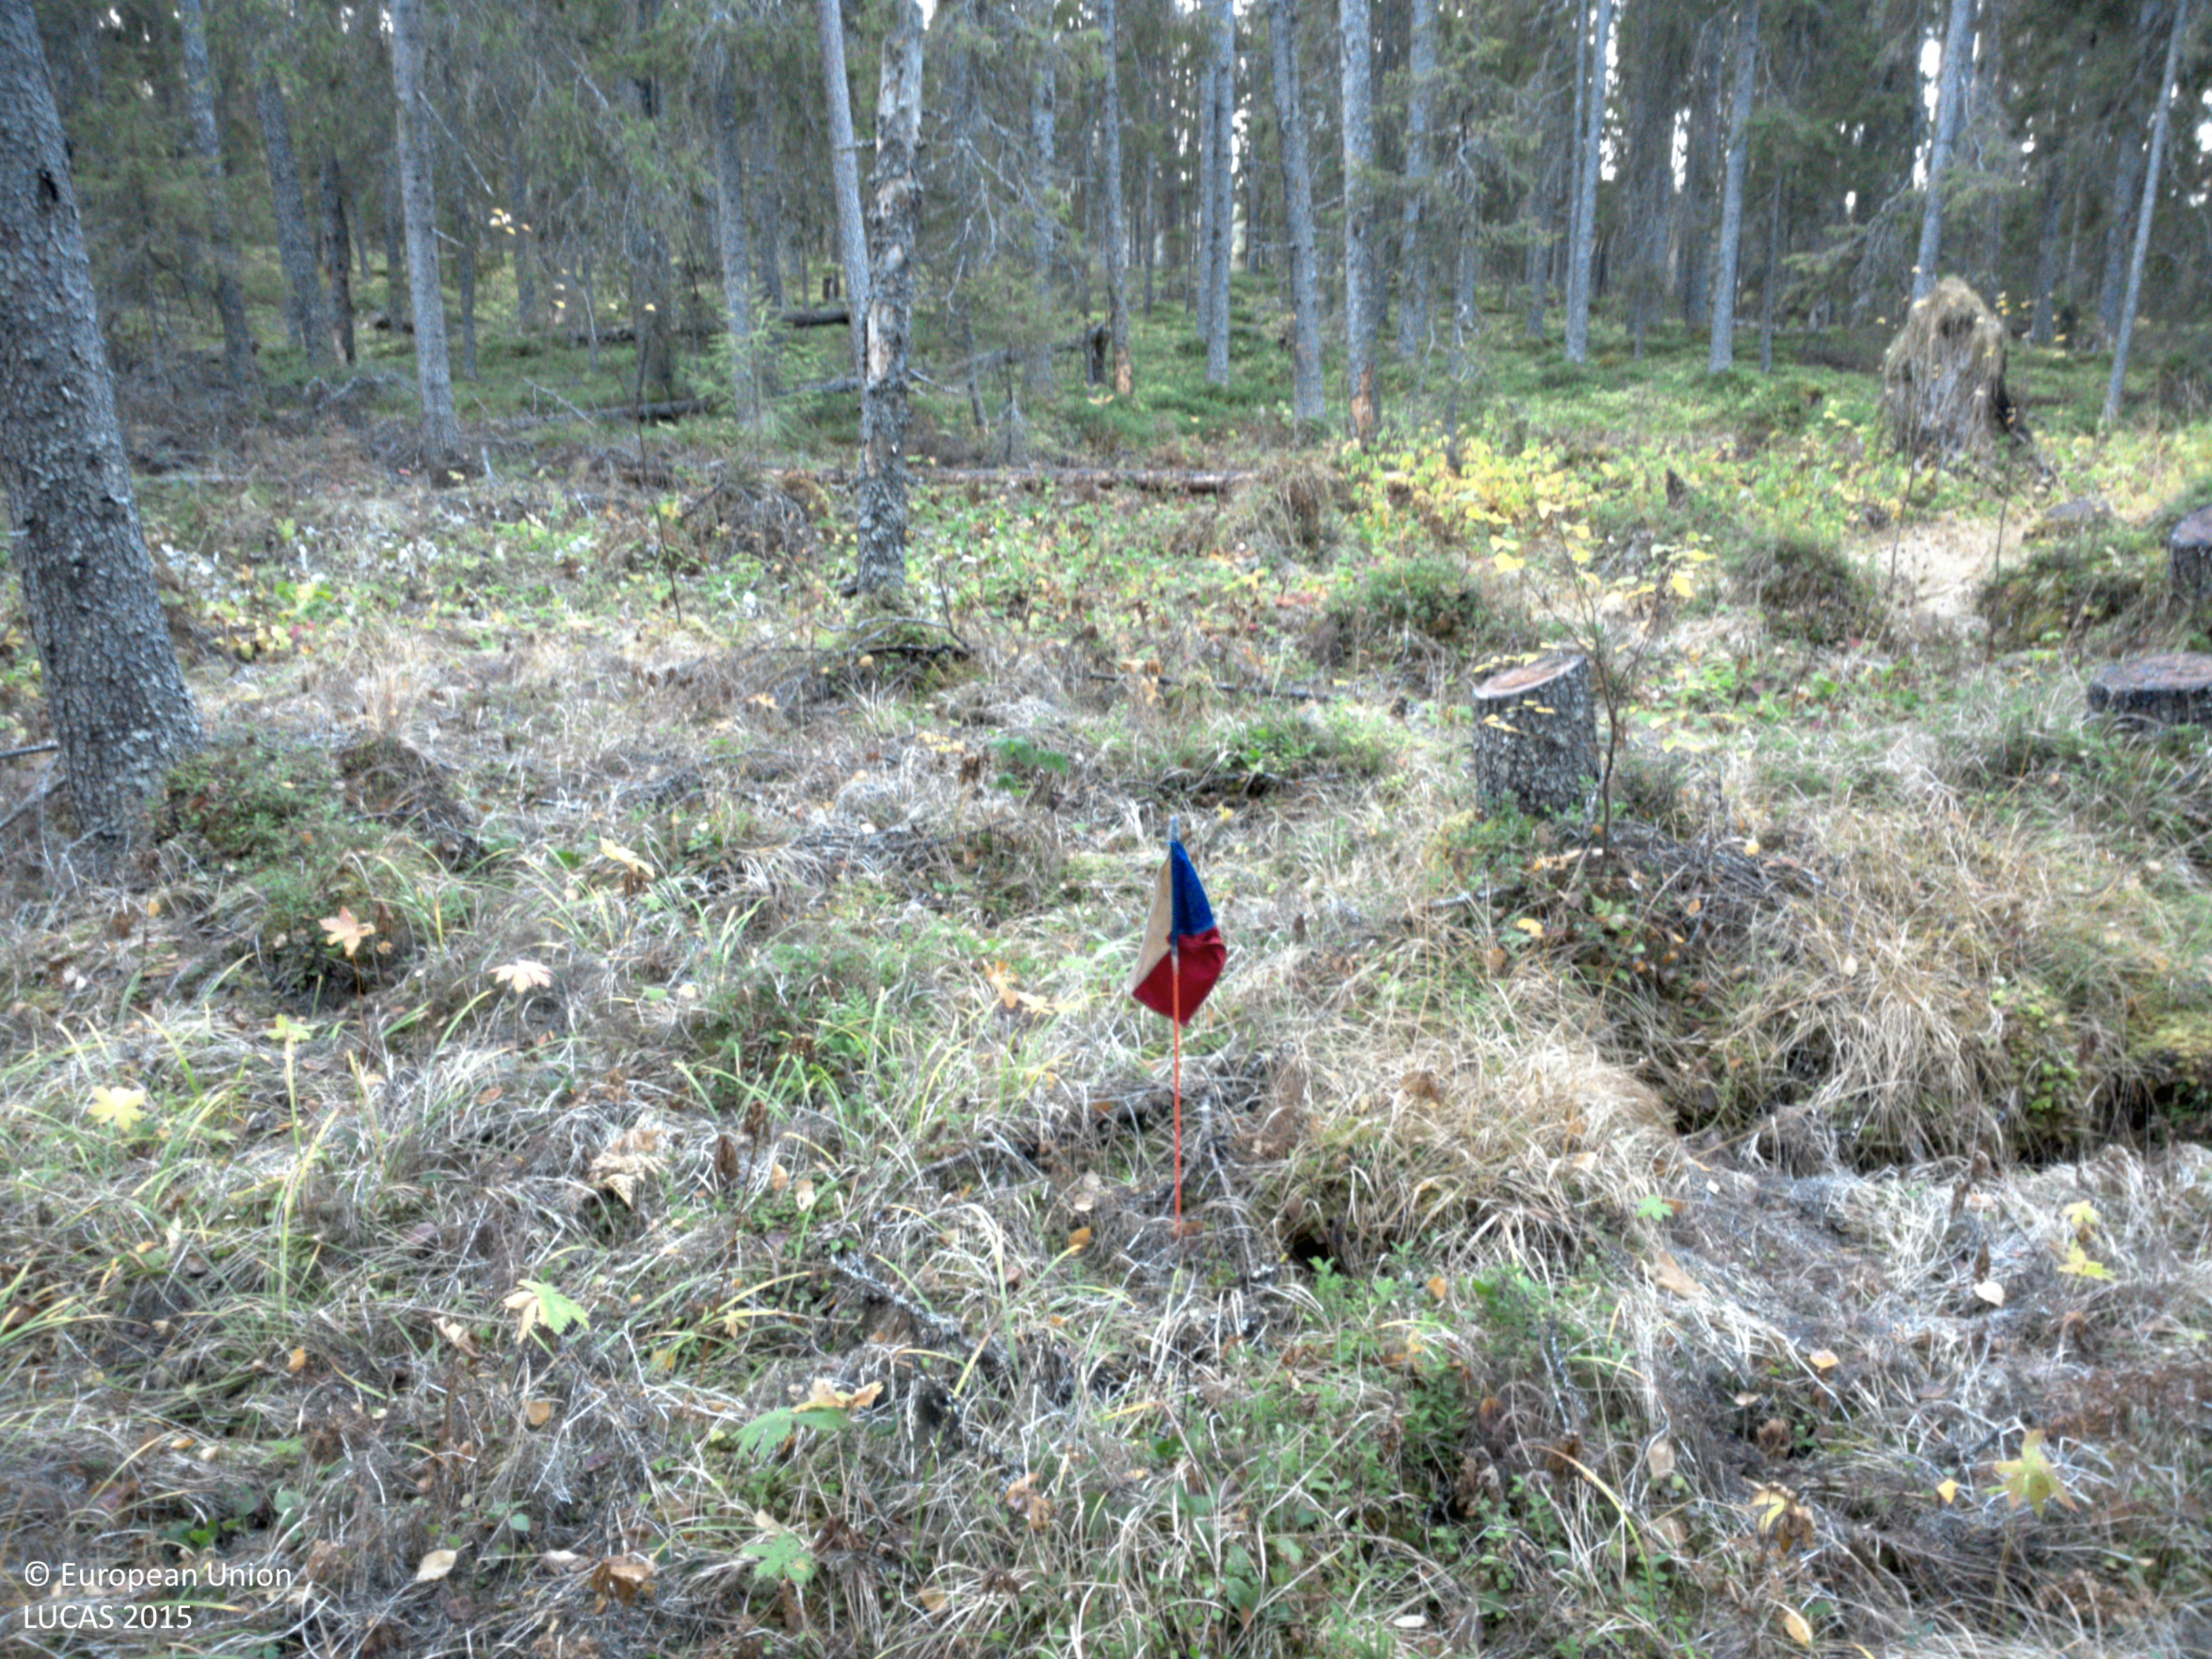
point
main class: Woodland
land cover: Spruce dominated coniferous woodland
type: boreal forest
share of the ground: 25 - 50 %
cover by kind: coniferous forest trees 50 %, herbaceous plants 30 %, shrubs 10 %, lichens and mosses 10 %
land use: Forestry
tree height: > 5 m
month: October
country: SE
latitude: 64.8744
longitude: 17.8799
